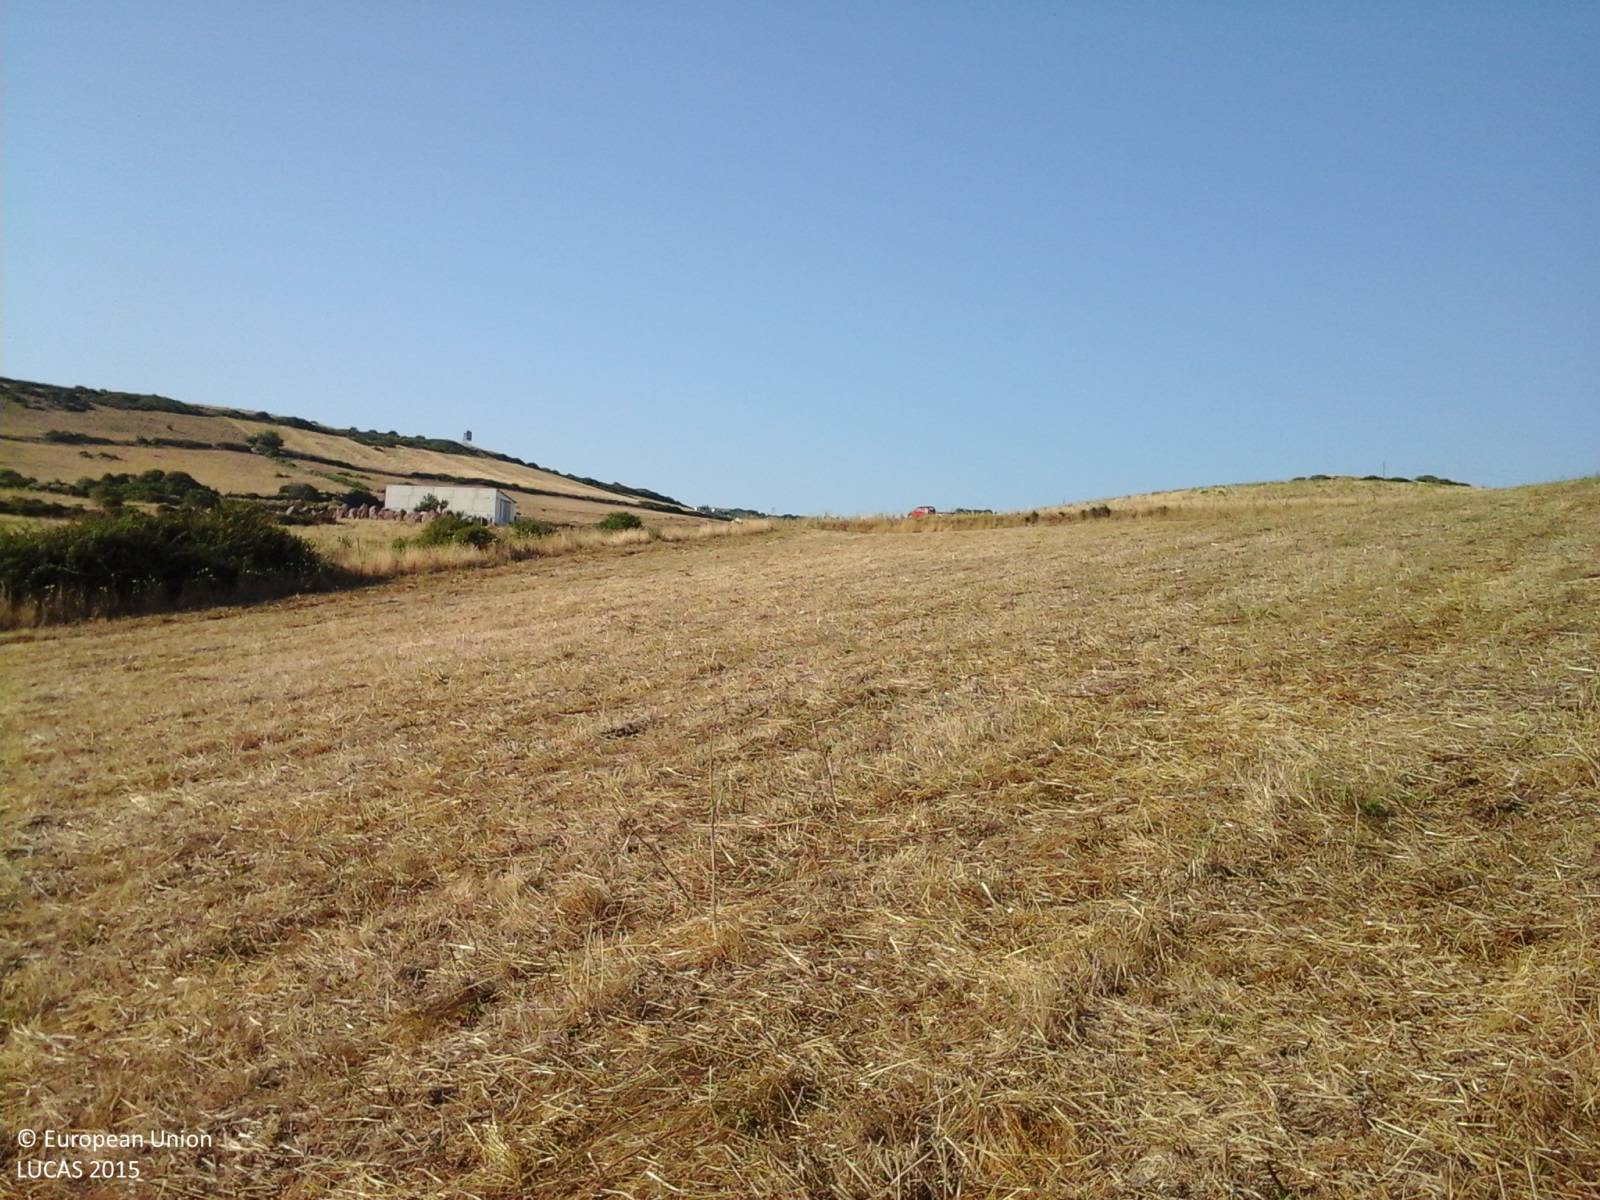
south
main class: Cropland
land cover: Oats
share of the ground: > 75 %
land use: Agriculture (excluding fallow land and kitchen gardens)
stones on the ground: < 10 %
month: July
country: IT
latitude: 40.7672
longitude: 8.8328
